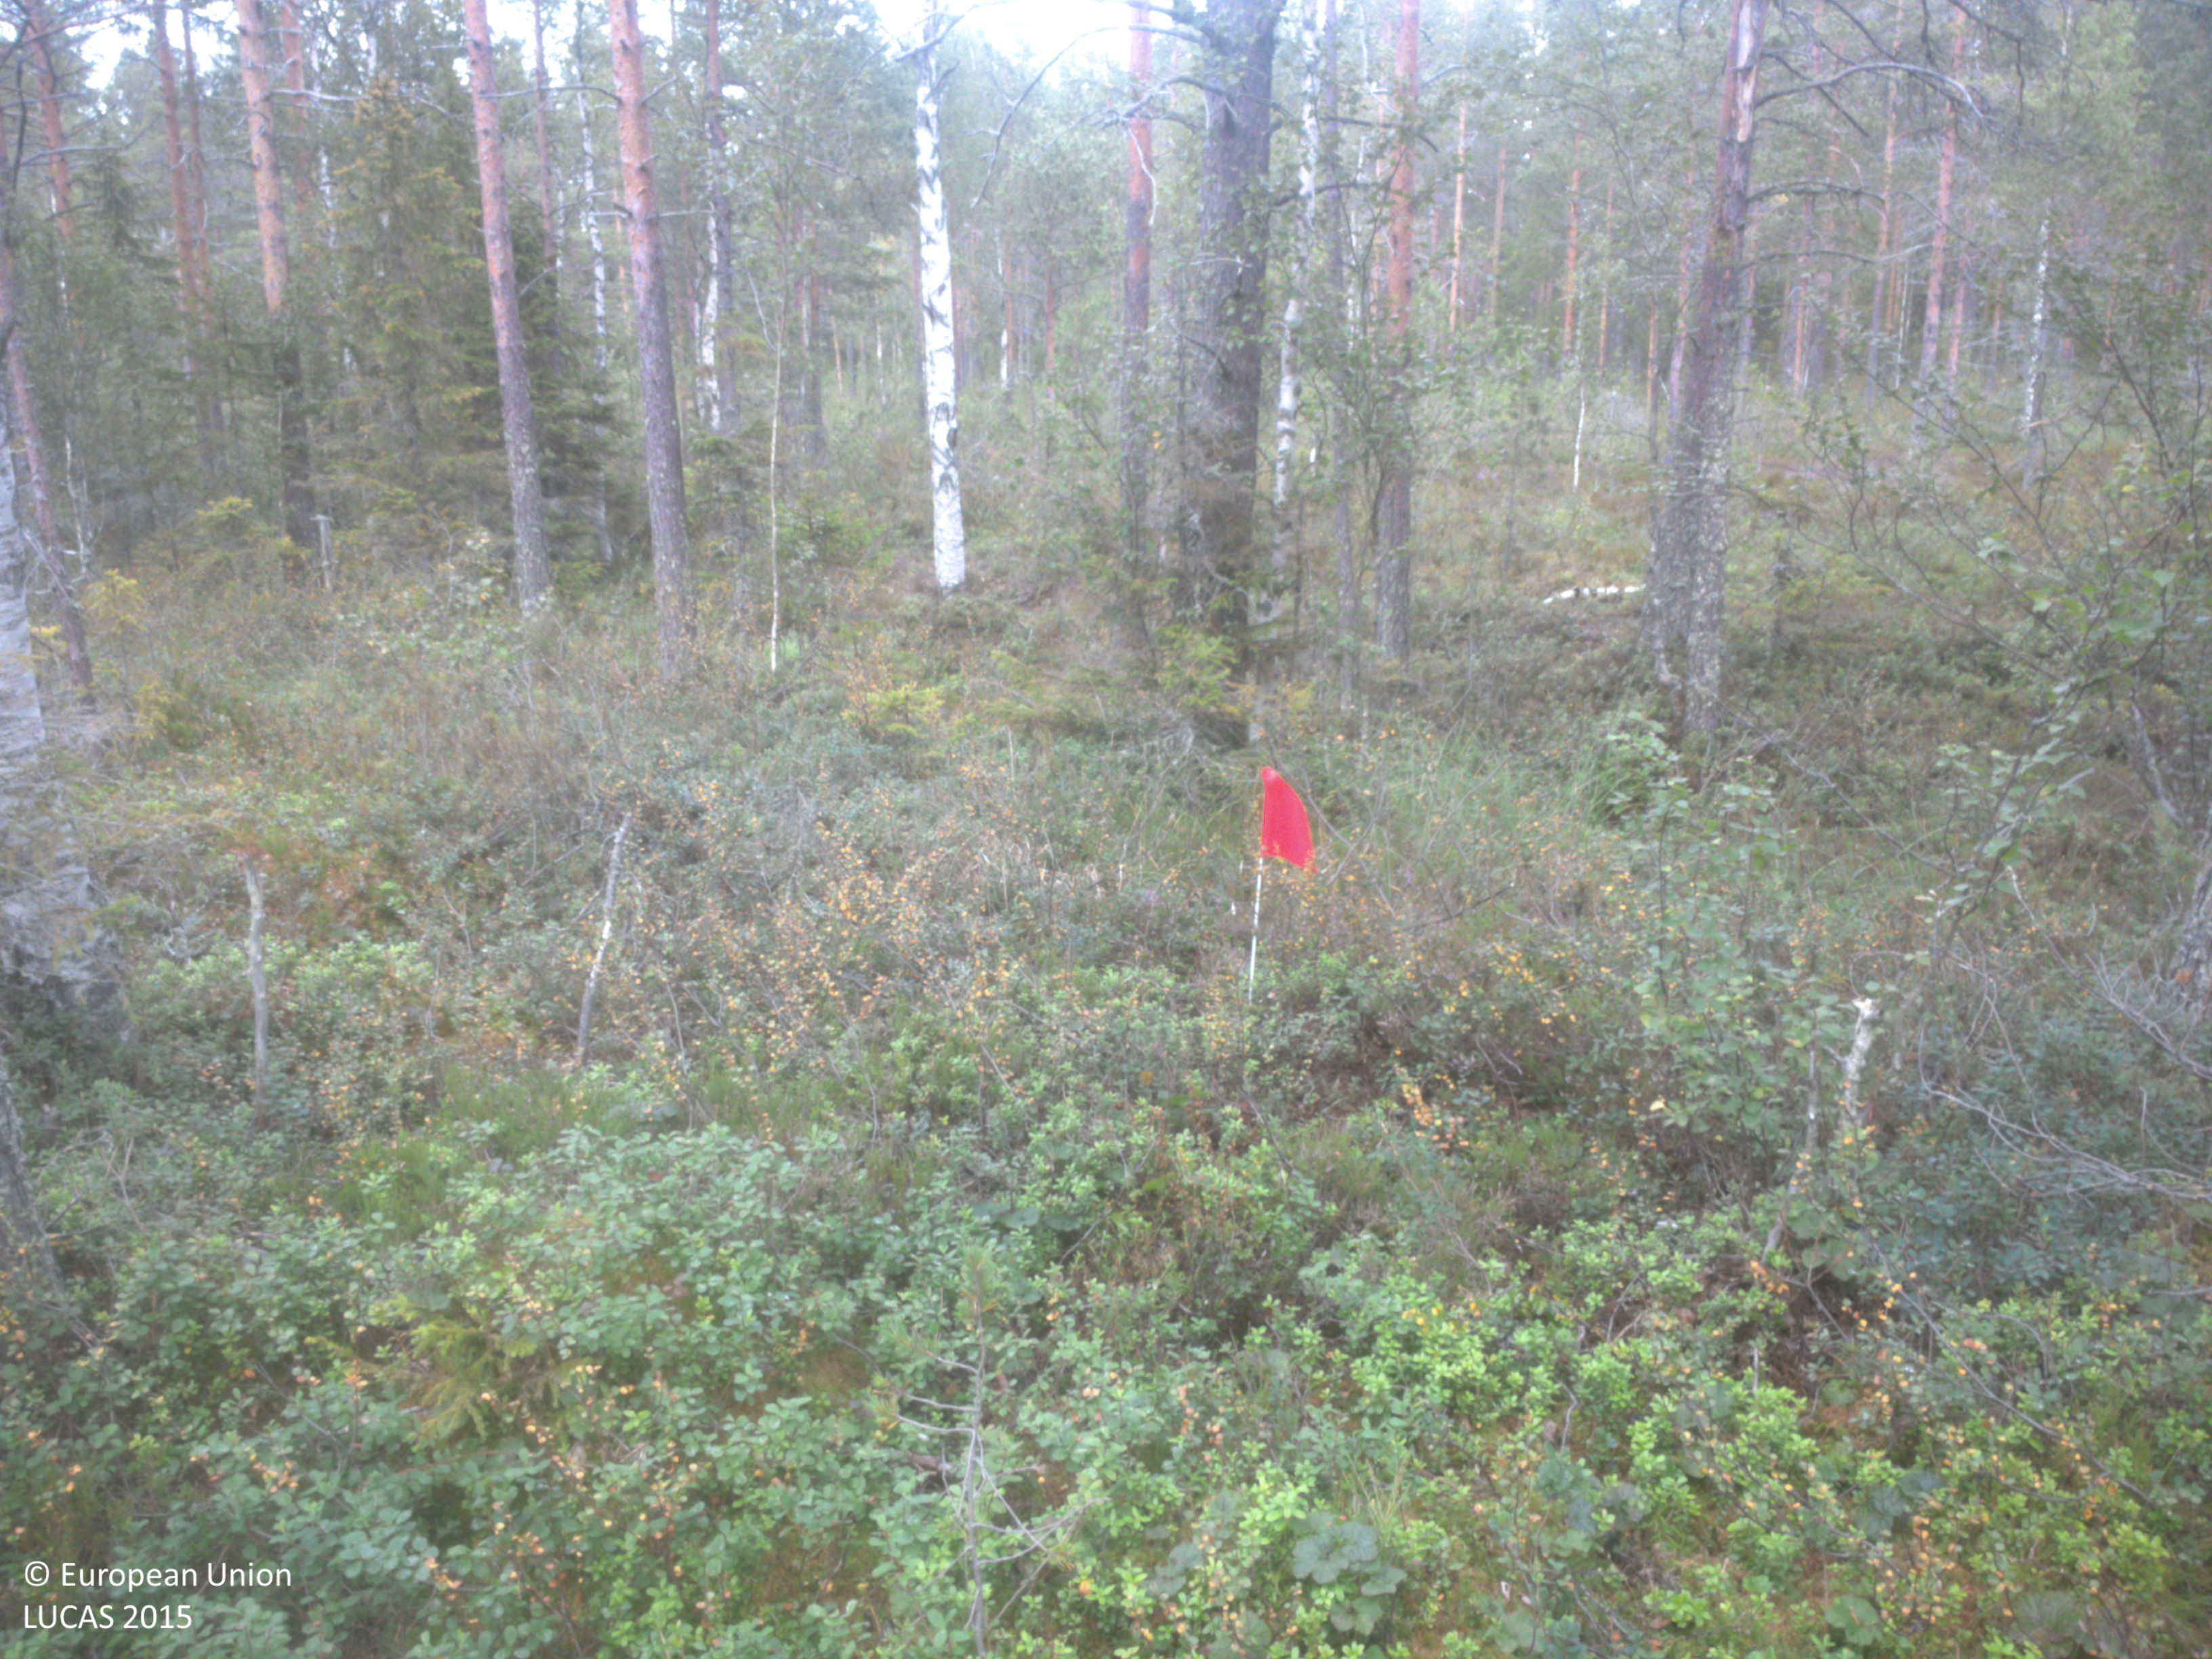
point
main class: Woodland
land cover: Pine dominated mixed woodland
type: boreal forest
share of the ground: 50 - 75 %
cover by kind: shrubs 45 %, coniferous forest trees 30 %, broadleaved forest trees 20 %, lichens and mosses 5 %
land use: Forestry
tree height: > 5 m
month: August
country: SE
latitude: 63.7225
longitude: 19.9210
